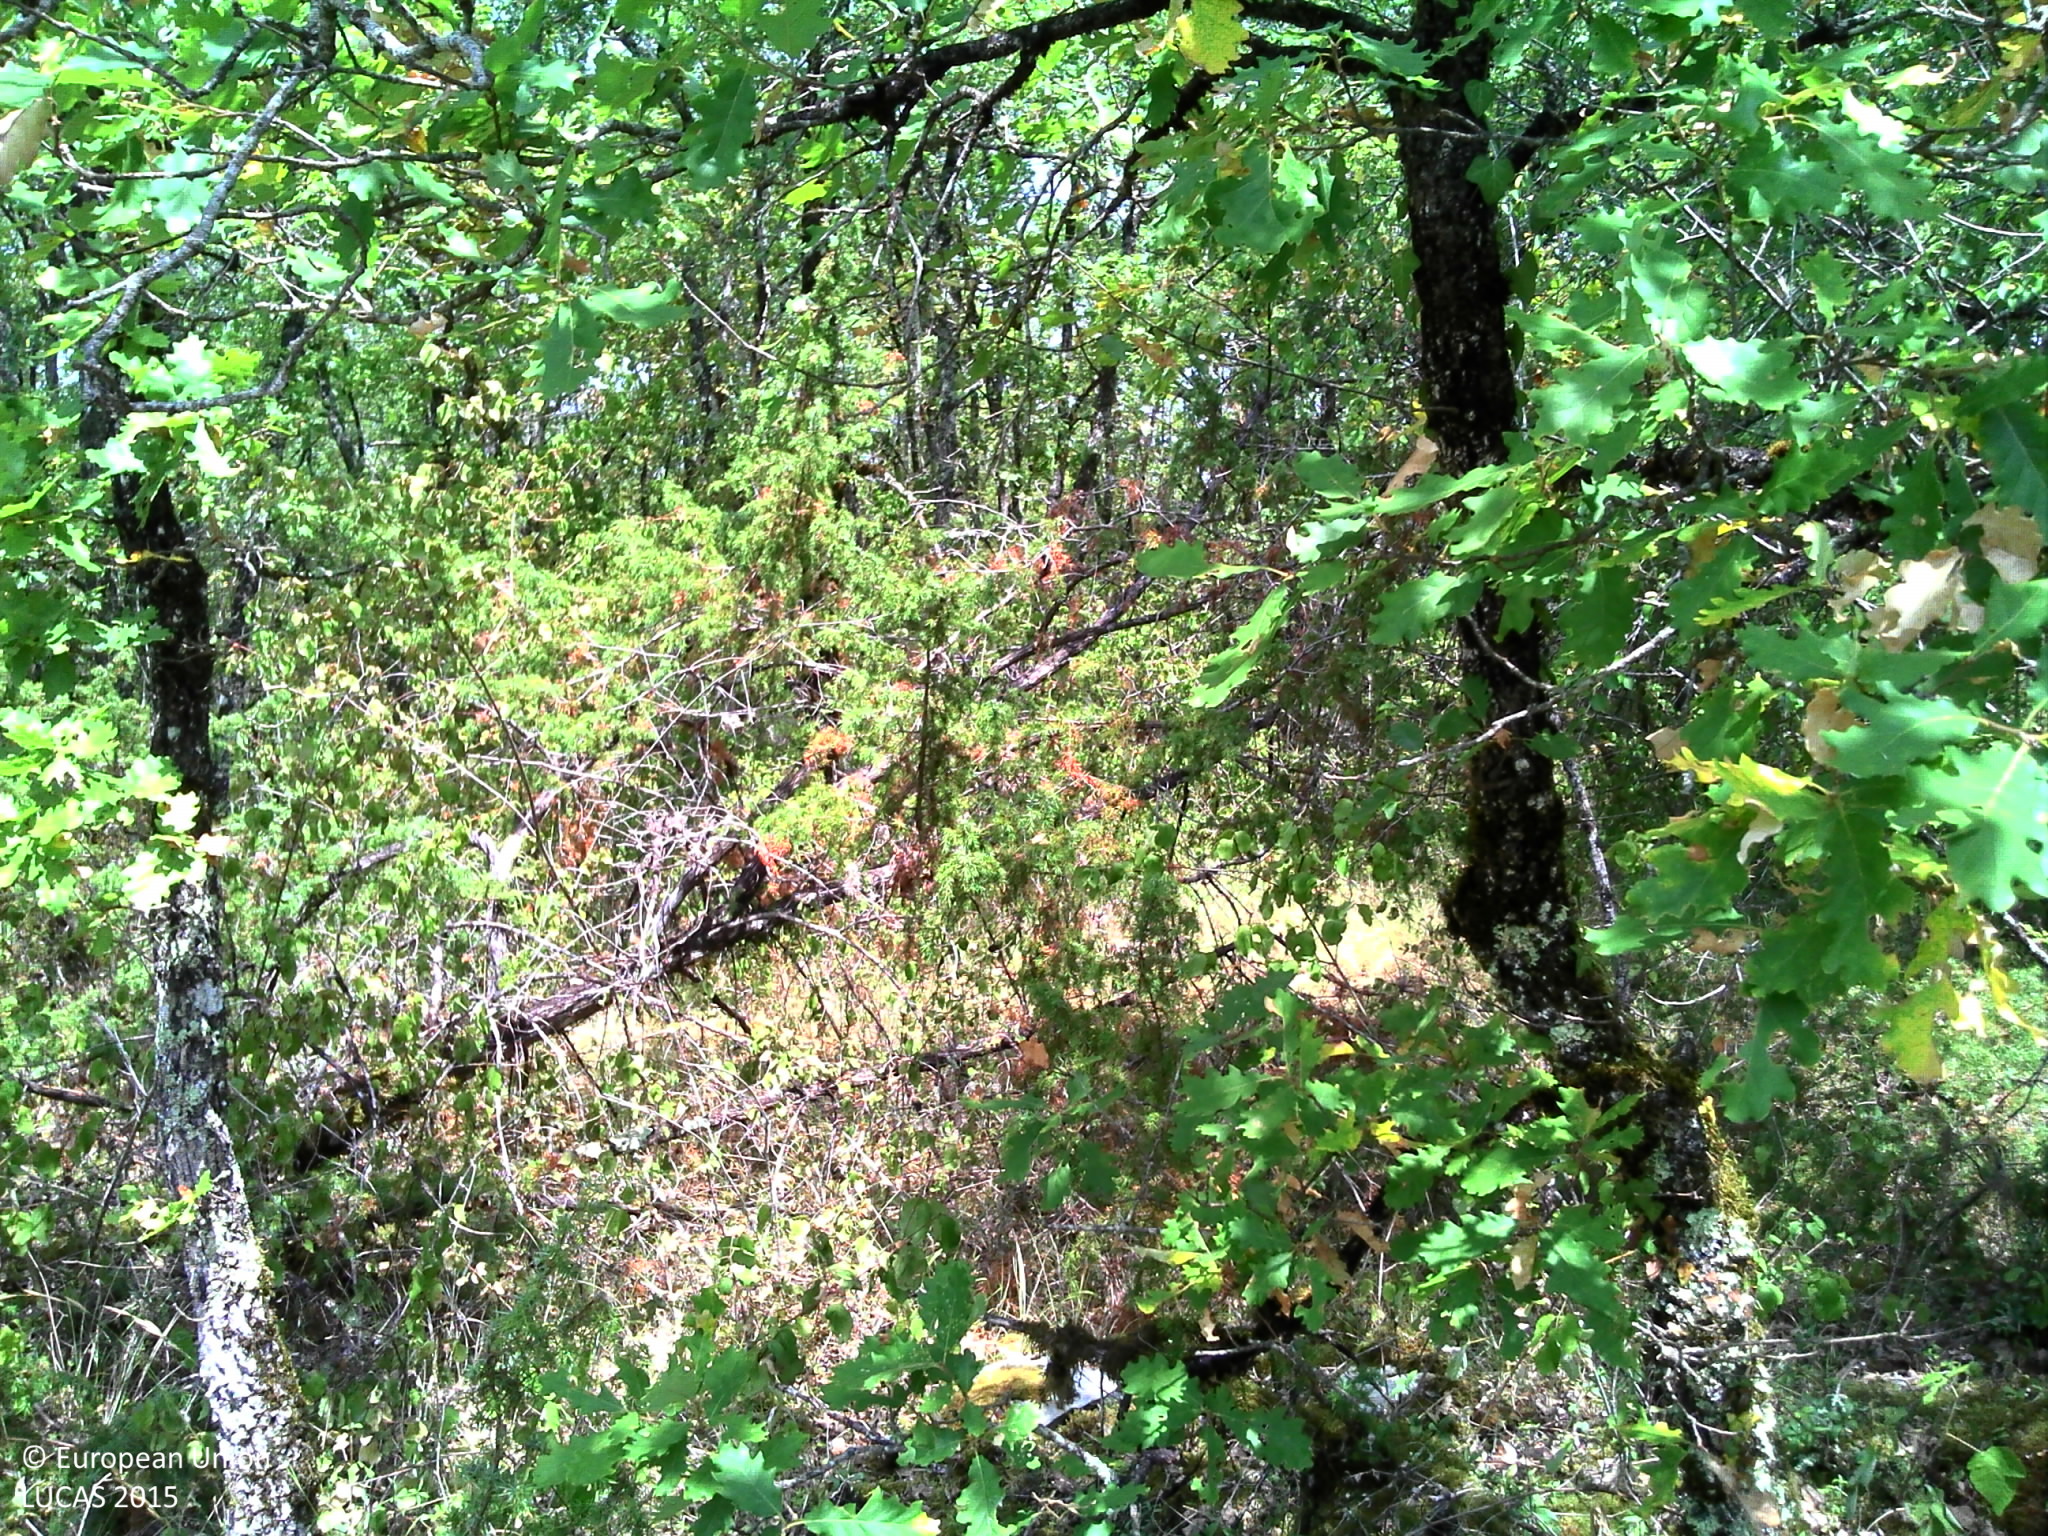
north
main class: Woodland
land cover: Broadleaved woodland
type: acidophilous oak and oak-birch forest
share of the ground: > 75 %
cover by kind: broadleaved forest trees 70 %, herbaceous plants 20 %, shrubs 10 %
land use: Forestry
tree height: > 5 m
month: July
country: FR
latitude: 45.1820
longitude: 1.0970
